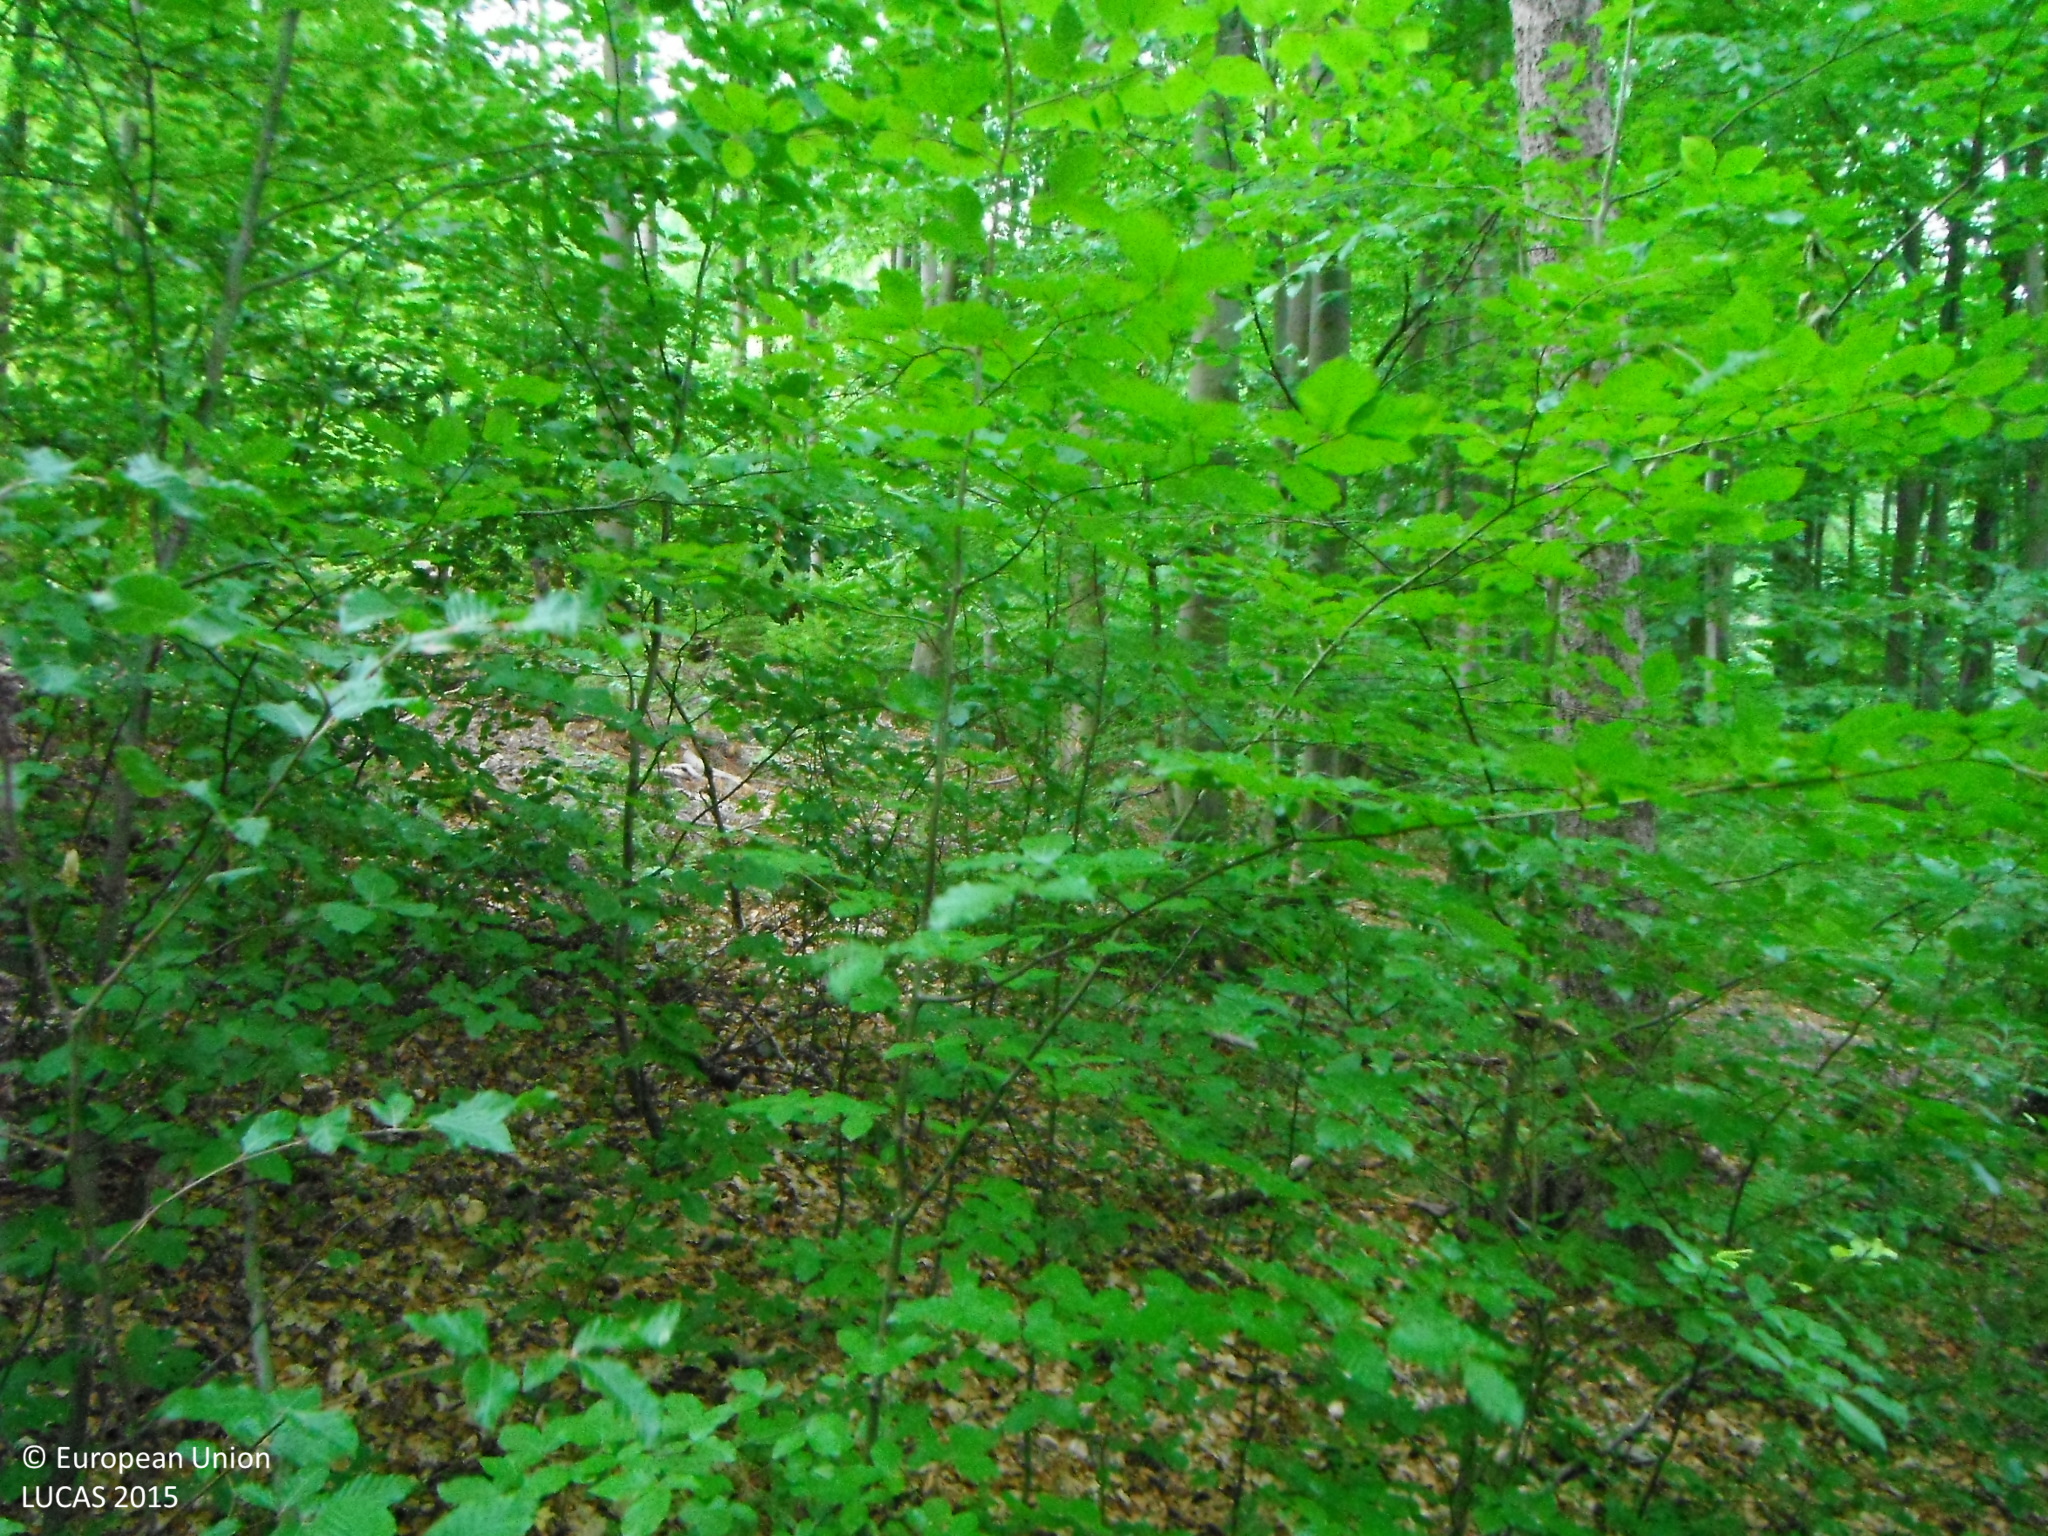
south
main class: Woodland
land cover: Spruce dominated mixed woodland
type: alpine coniferous forest
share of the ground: > 75 %
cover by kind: coniferous forest trees 60 %, broadleaved forest trees 40 %
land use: Forestry
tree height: > 5 m
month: June
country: SK
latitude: 48.5204
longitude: 19.2701
